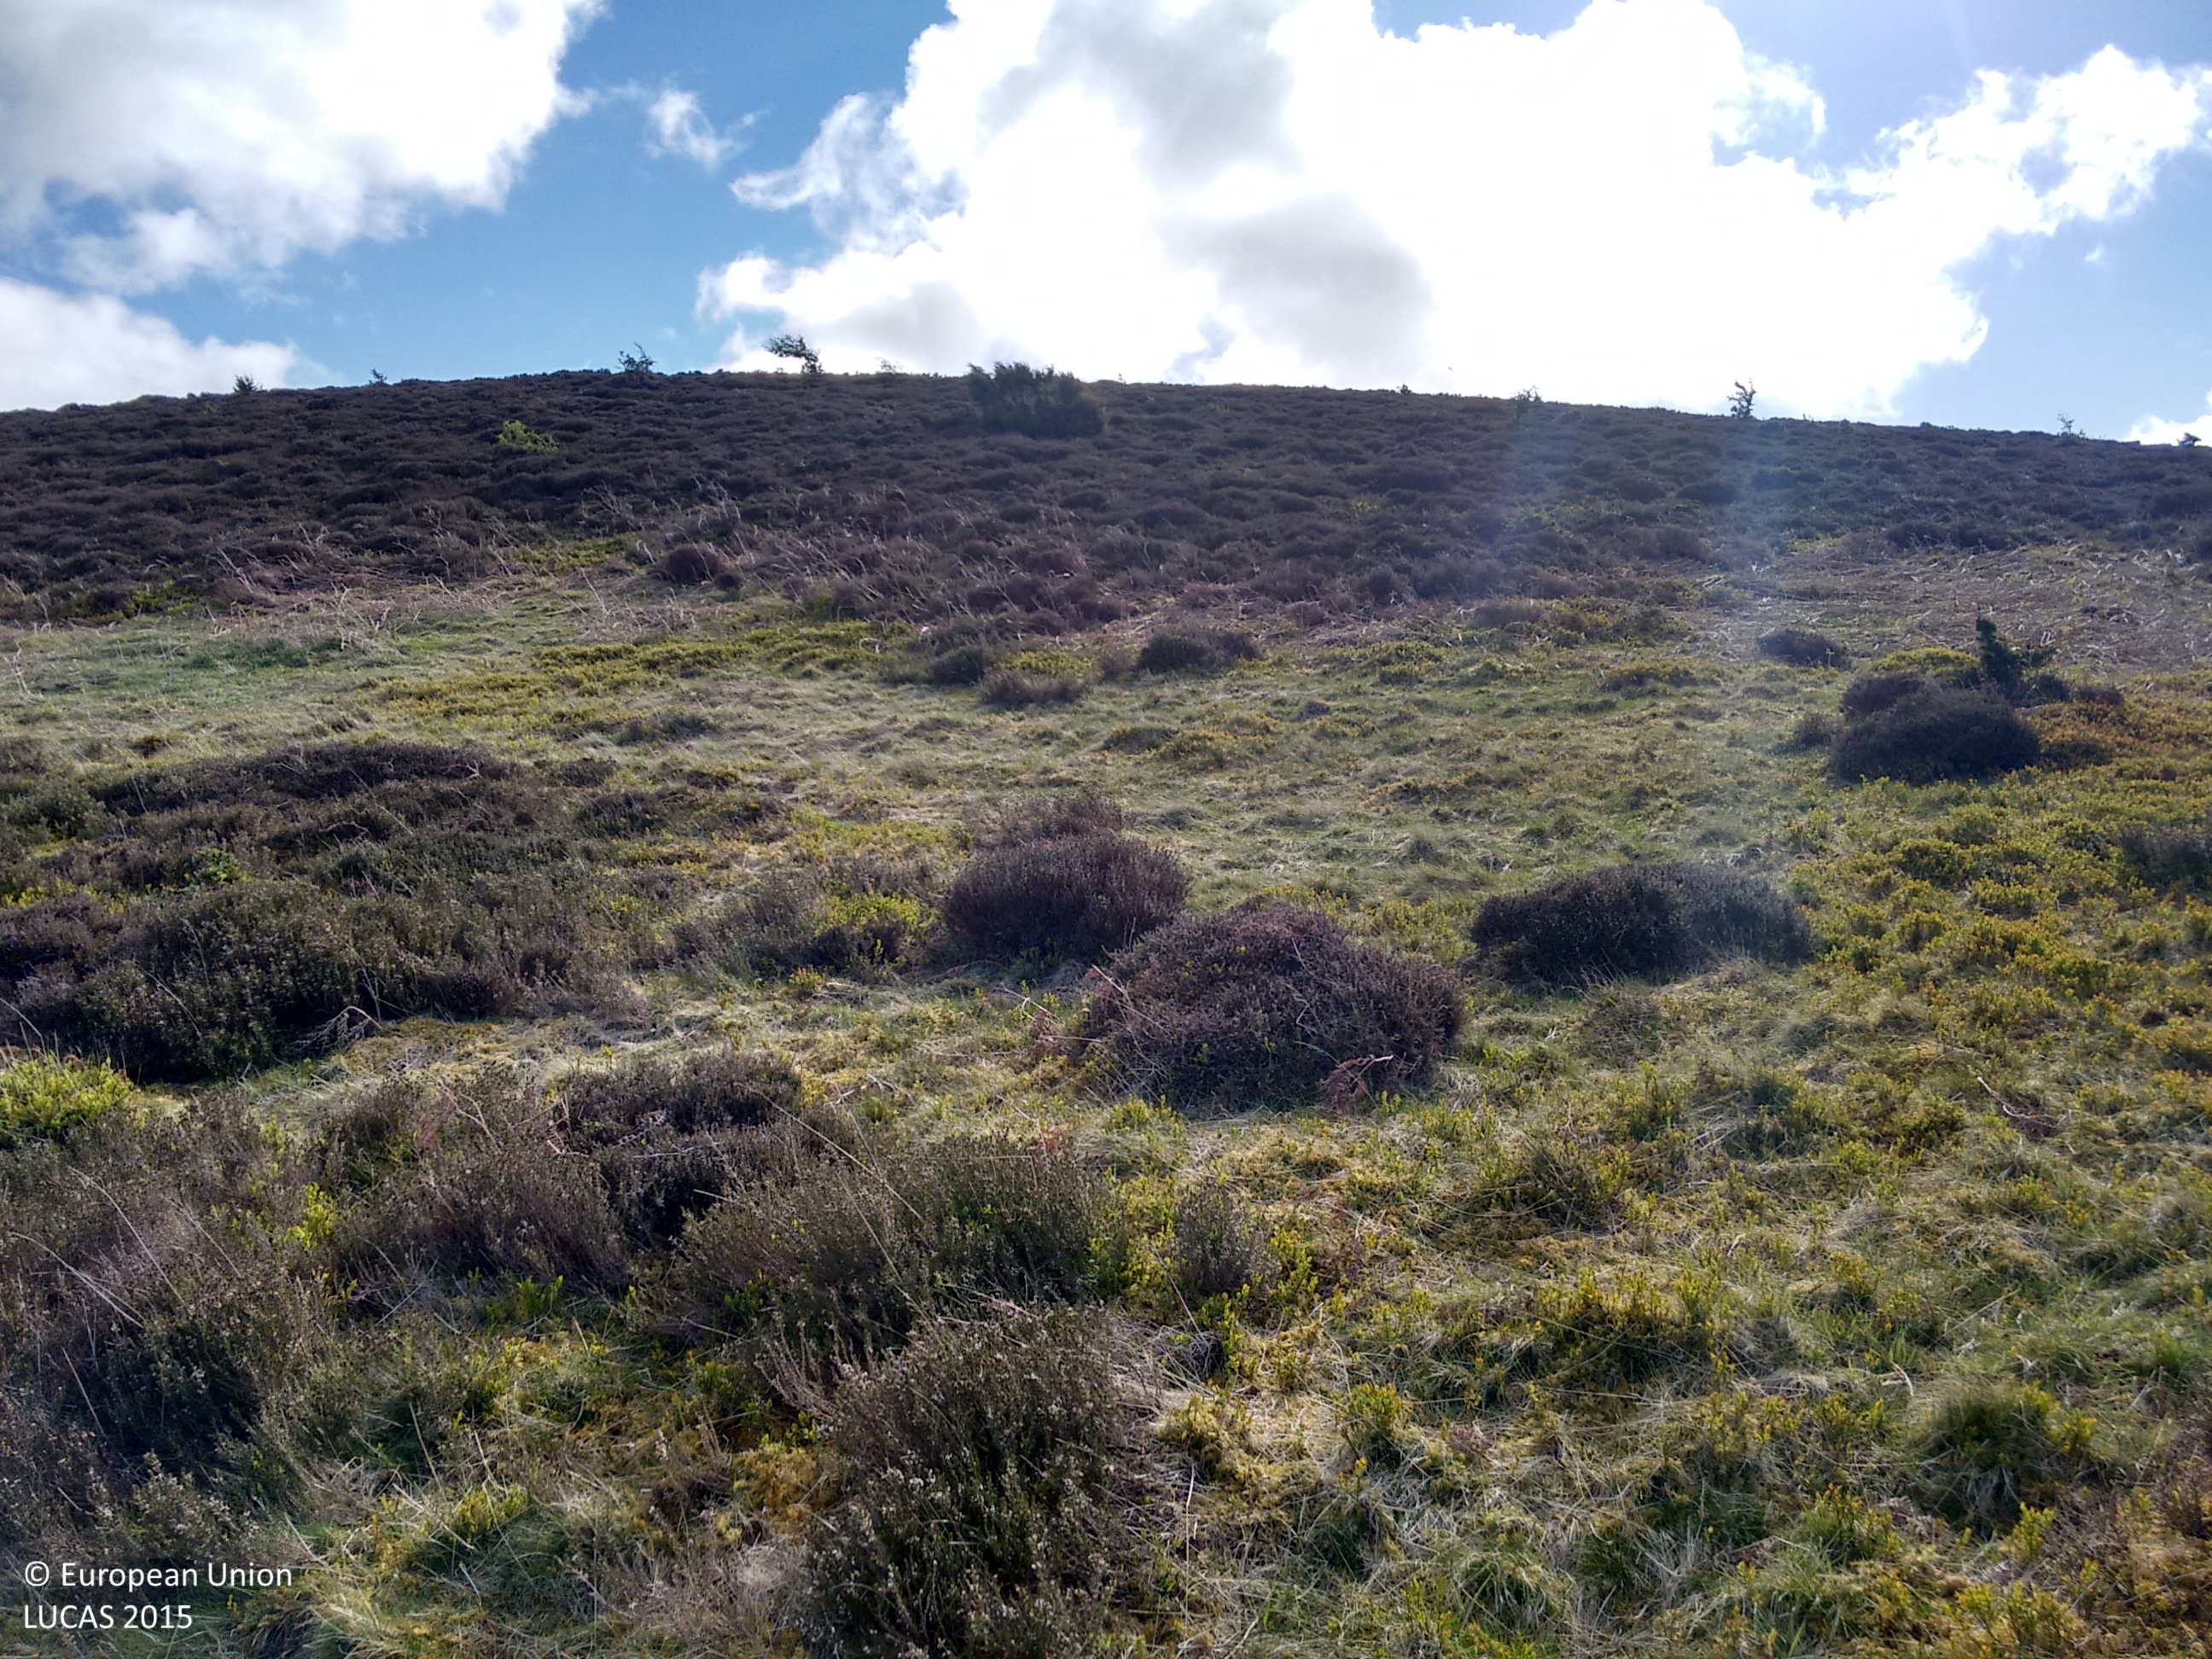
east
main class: Shrubland
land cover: Shrubland without tree cover
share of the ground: > 75 %
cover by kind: shrubs 80 %, herbaceous plants 20 %
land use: Agriculture (excluding fallow land and kitchen gardens)
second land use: Other primary production
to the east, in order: Shrubland without tree cover
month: June
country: GB
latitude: 55.8536
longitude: -2.7963
